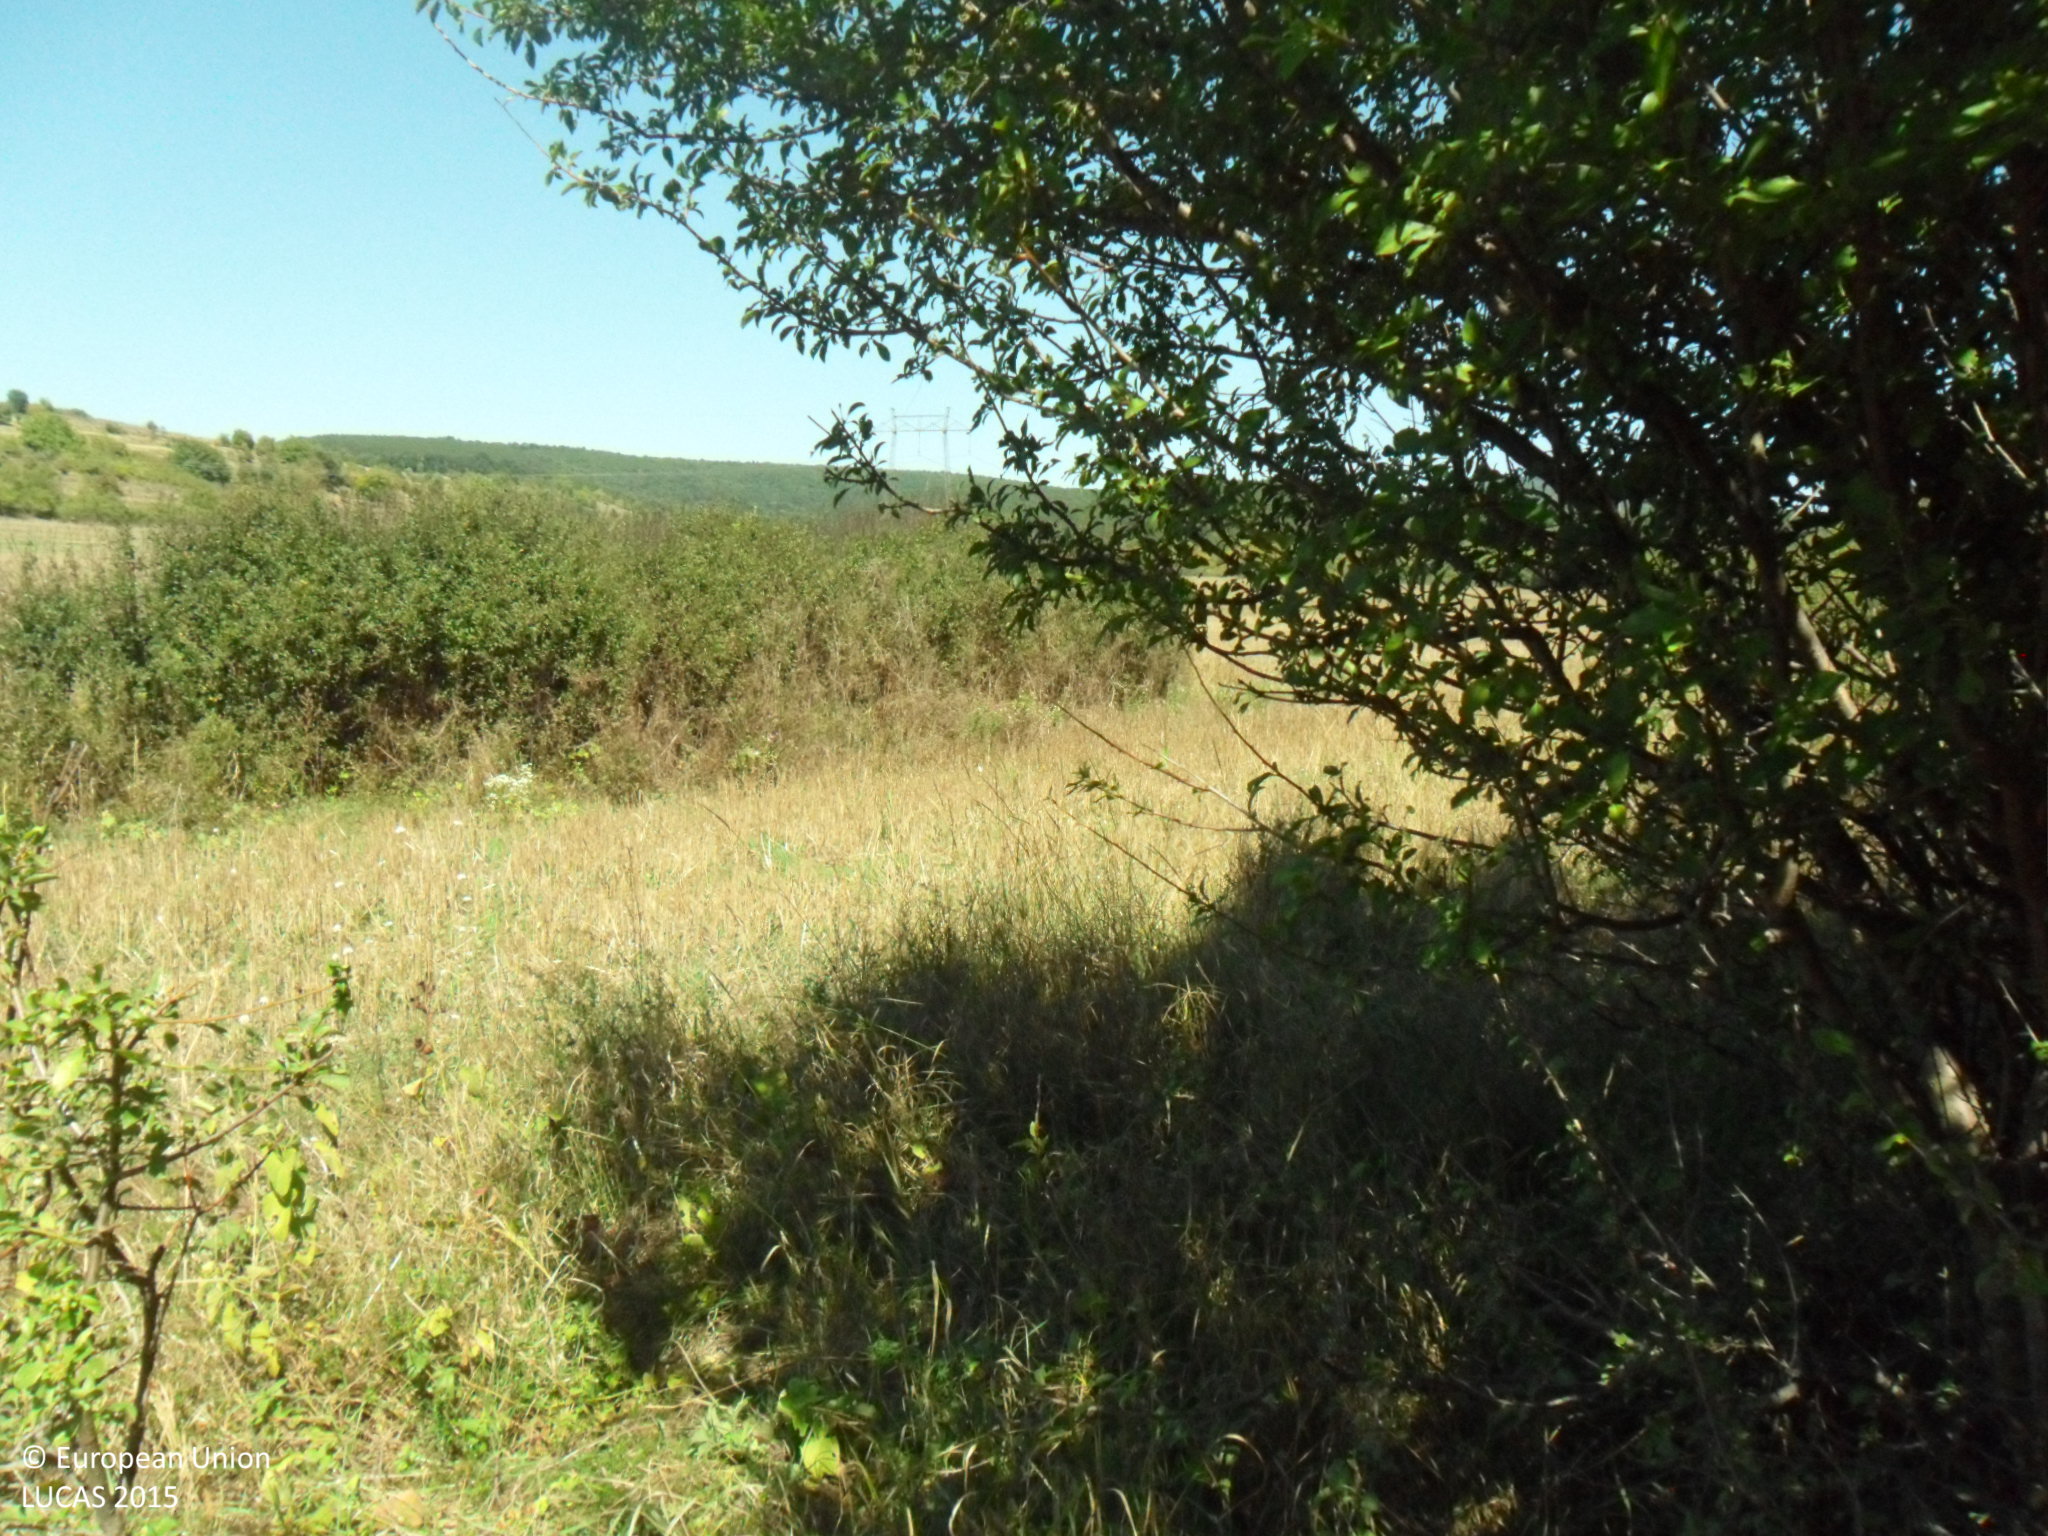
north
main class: Woodland
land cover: Broadleaved woodland
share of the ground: > 75 %
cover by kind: broadleaved forest trees 70 %, shrubs 25 %, herbaceous plants 5 %
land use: Semi-natural and natural areas not in use
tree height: > 5 m
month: September
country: BG
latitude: 43.2629
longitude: 26.8021
